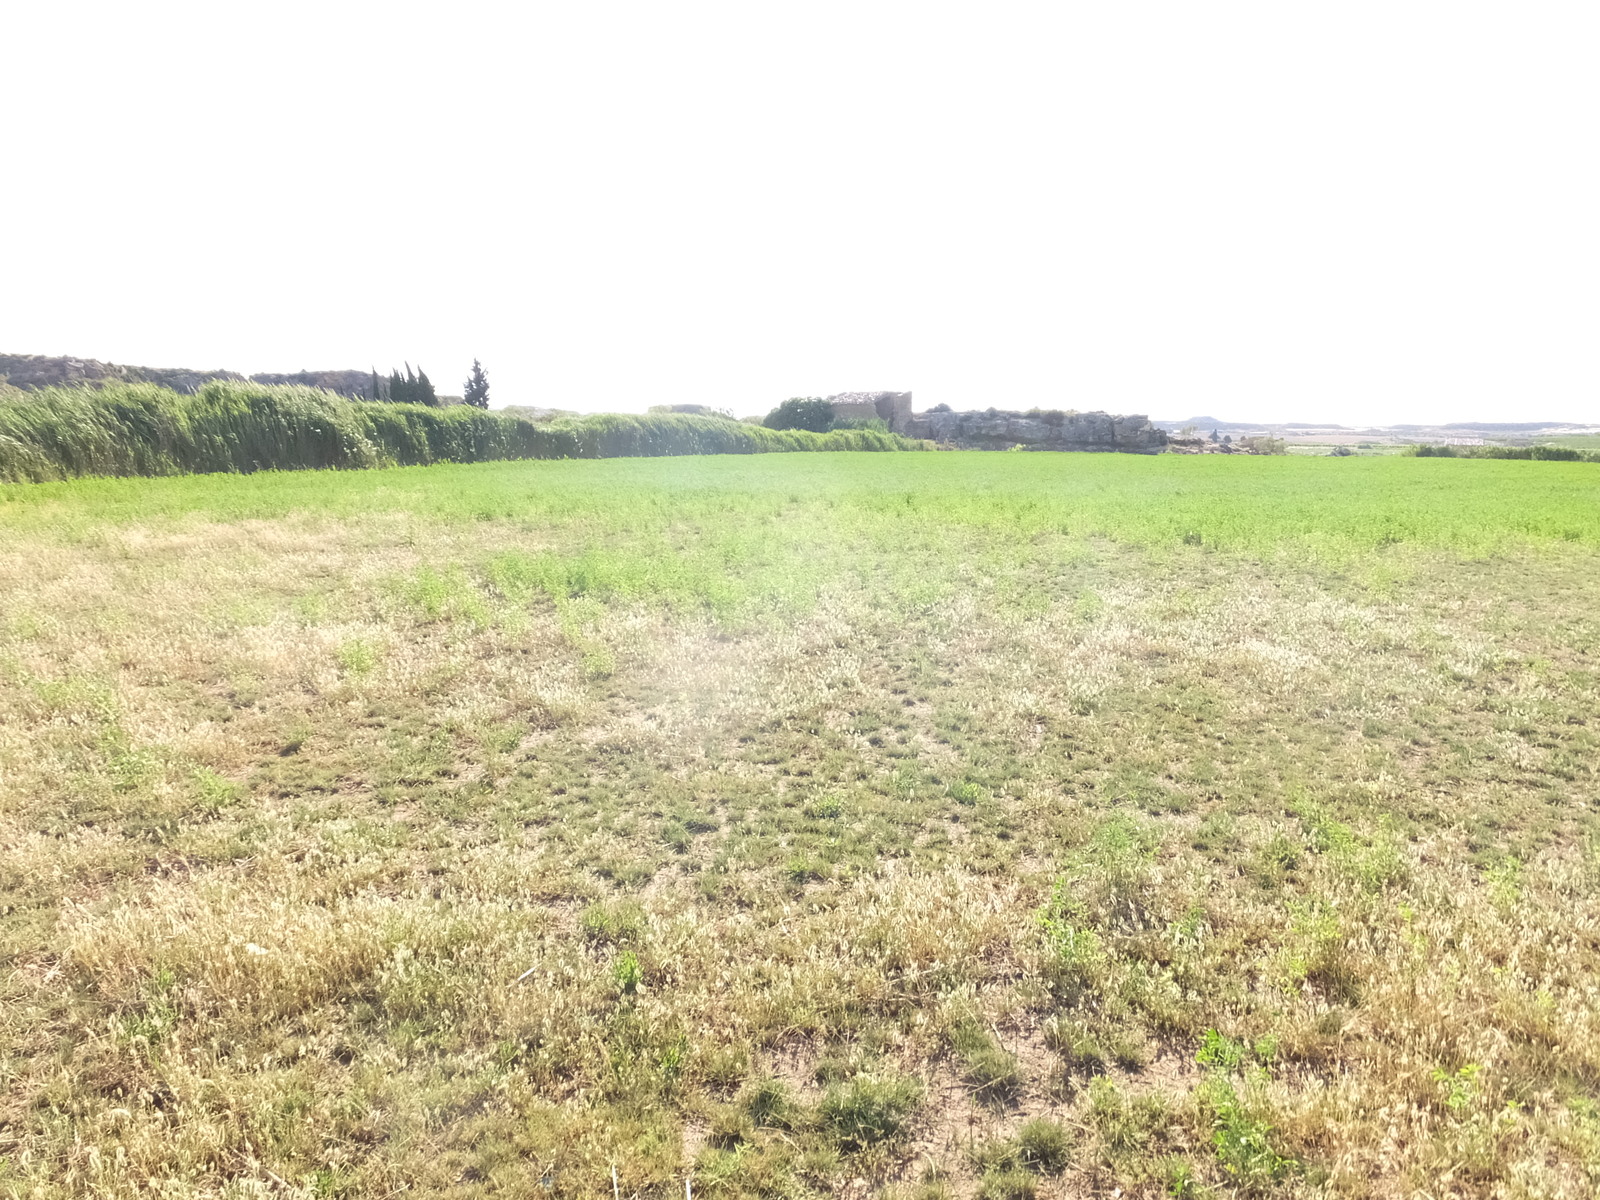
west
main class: Cropland
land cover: Lucerne
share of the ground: > 75 %
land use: Agriculture (excluding fallow land and kitchen gardens)
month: June
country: ES
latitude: 41.2136
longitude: -0.1630
